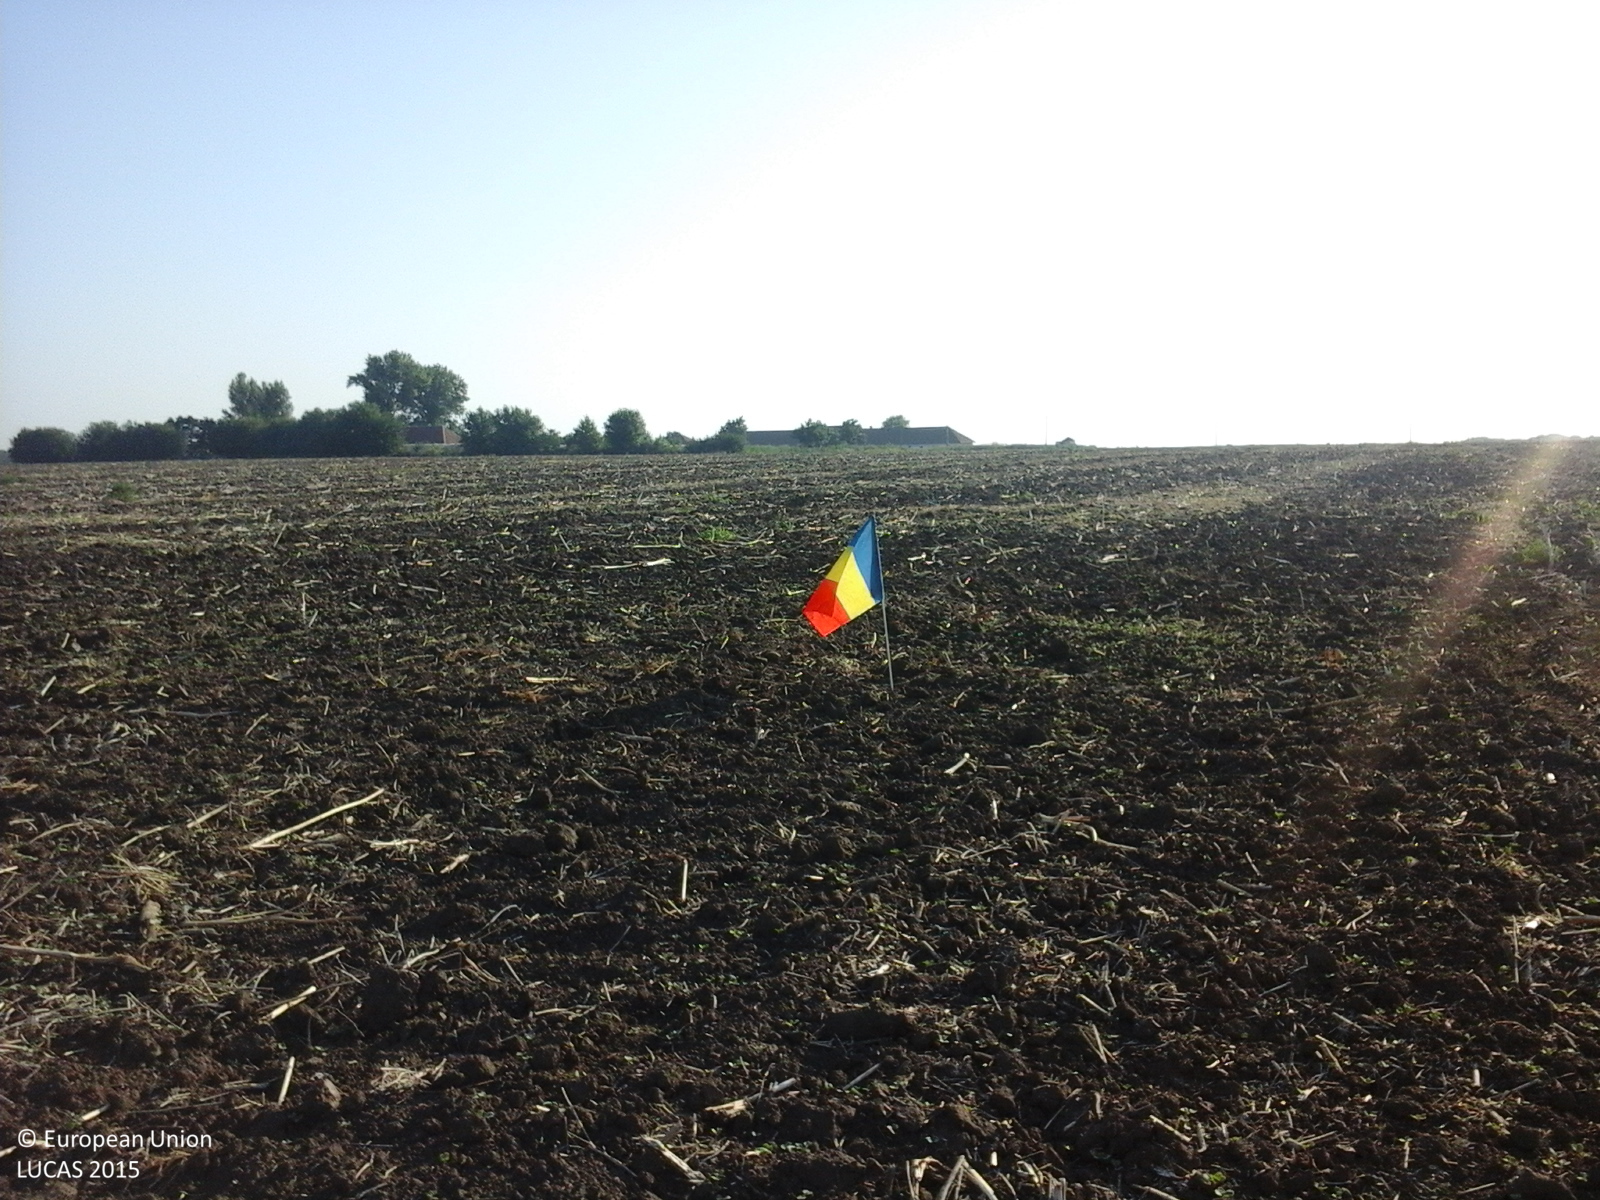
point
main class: Cropland
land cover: Rape and turnip rape
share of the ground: < 10 %
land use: Agriculture (excluding fallow land and kitchen gardens)
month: July
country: RO
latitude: 44.3874
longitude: 27.5540
